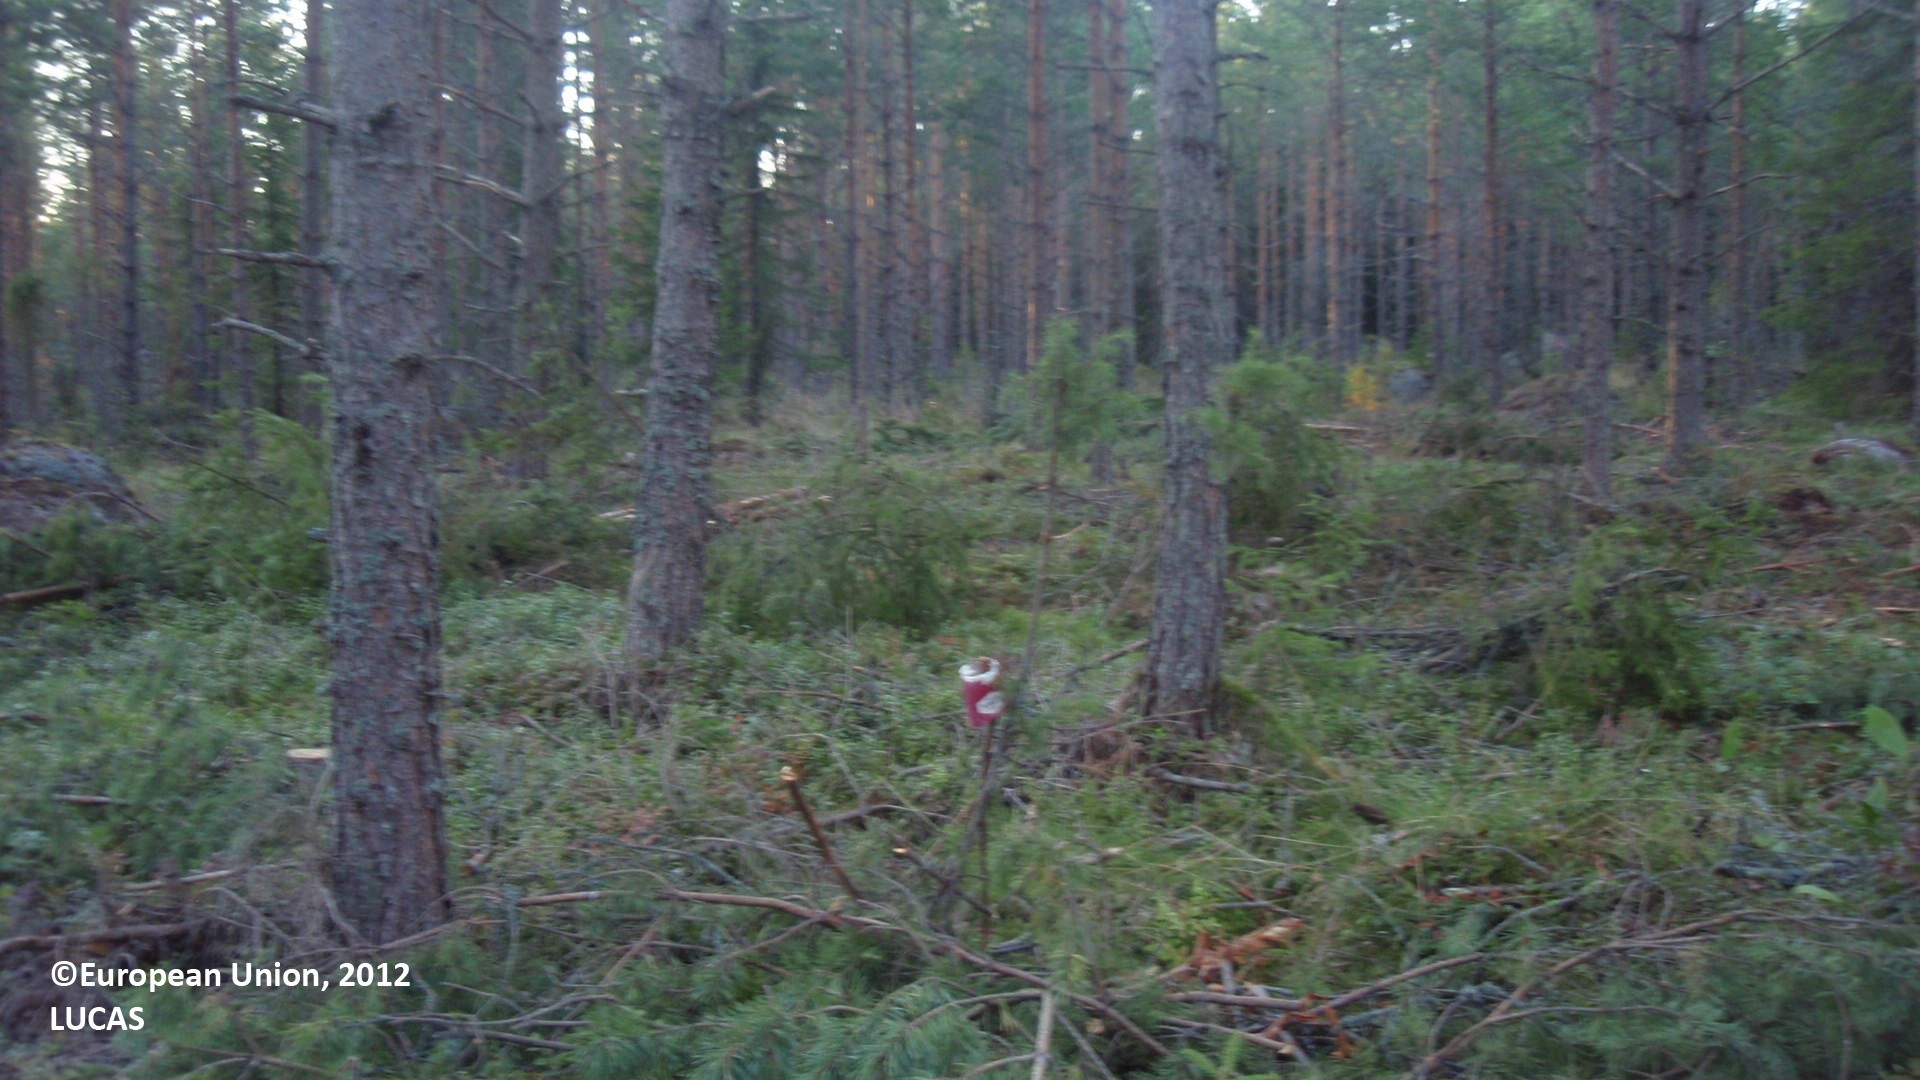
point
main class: Woodland
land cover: Pine dominated coniferous woodland
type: boreal forest
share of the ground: 50 - 75 %
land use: Forestry
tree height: > 5 m
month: August
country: FI
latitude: 60.5292
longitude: 27.4029
